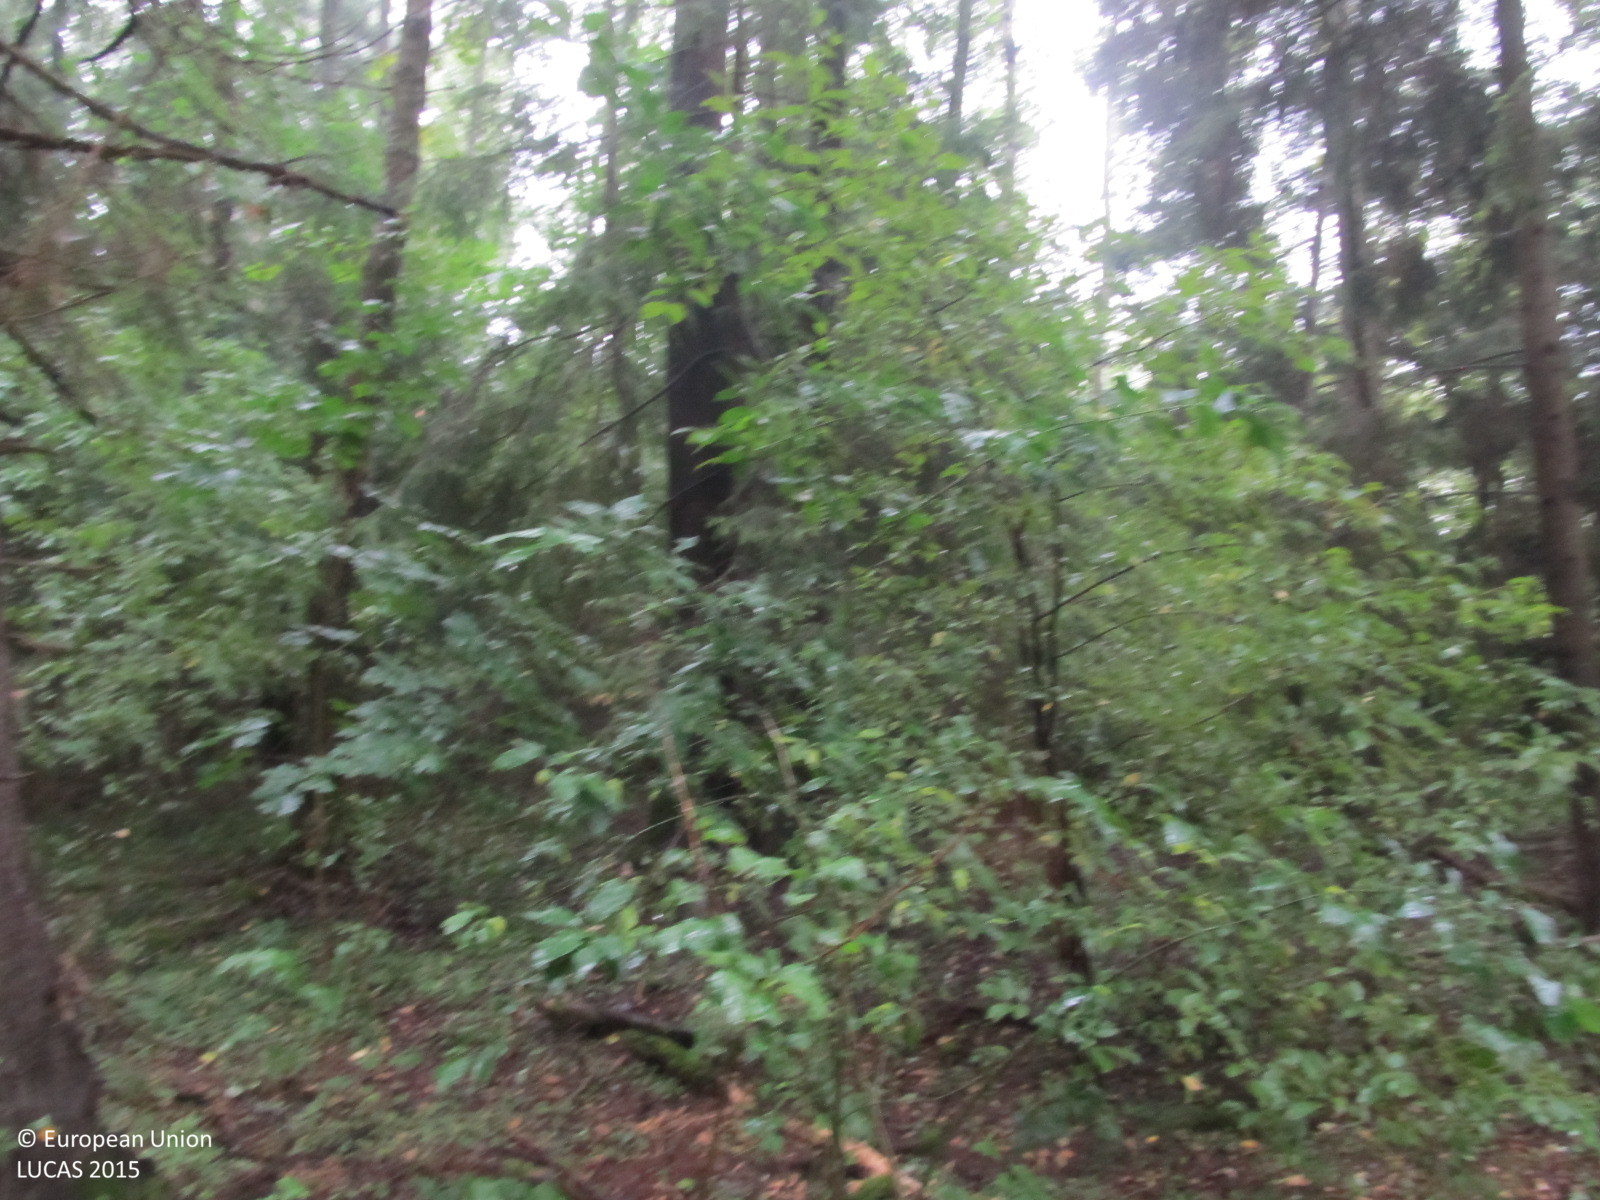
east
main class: Woodland
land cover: Other mixed woodland
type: hemiboreal forest and nemoral coniferous forest and mixed broadleaved-coniferous forest
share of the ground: > 75 %
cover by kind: coniferous forest trees 55 %, broadleaved forest trees 30 %, herbaceous plants 10 %, shrubs 5 %
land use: Forestry
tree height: > 5 m
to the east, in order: Other mixed woodland; Broadleaved woodland; Ditches and canals; Broadleaved woodland; Spontaneously vegetated surfaces; Other mixed woodland; Shruby margins; Tracks; Shruby margins; Broadleaved woodland; Tracks
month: September
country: LT
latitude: 56.0956
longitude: 23.1058
